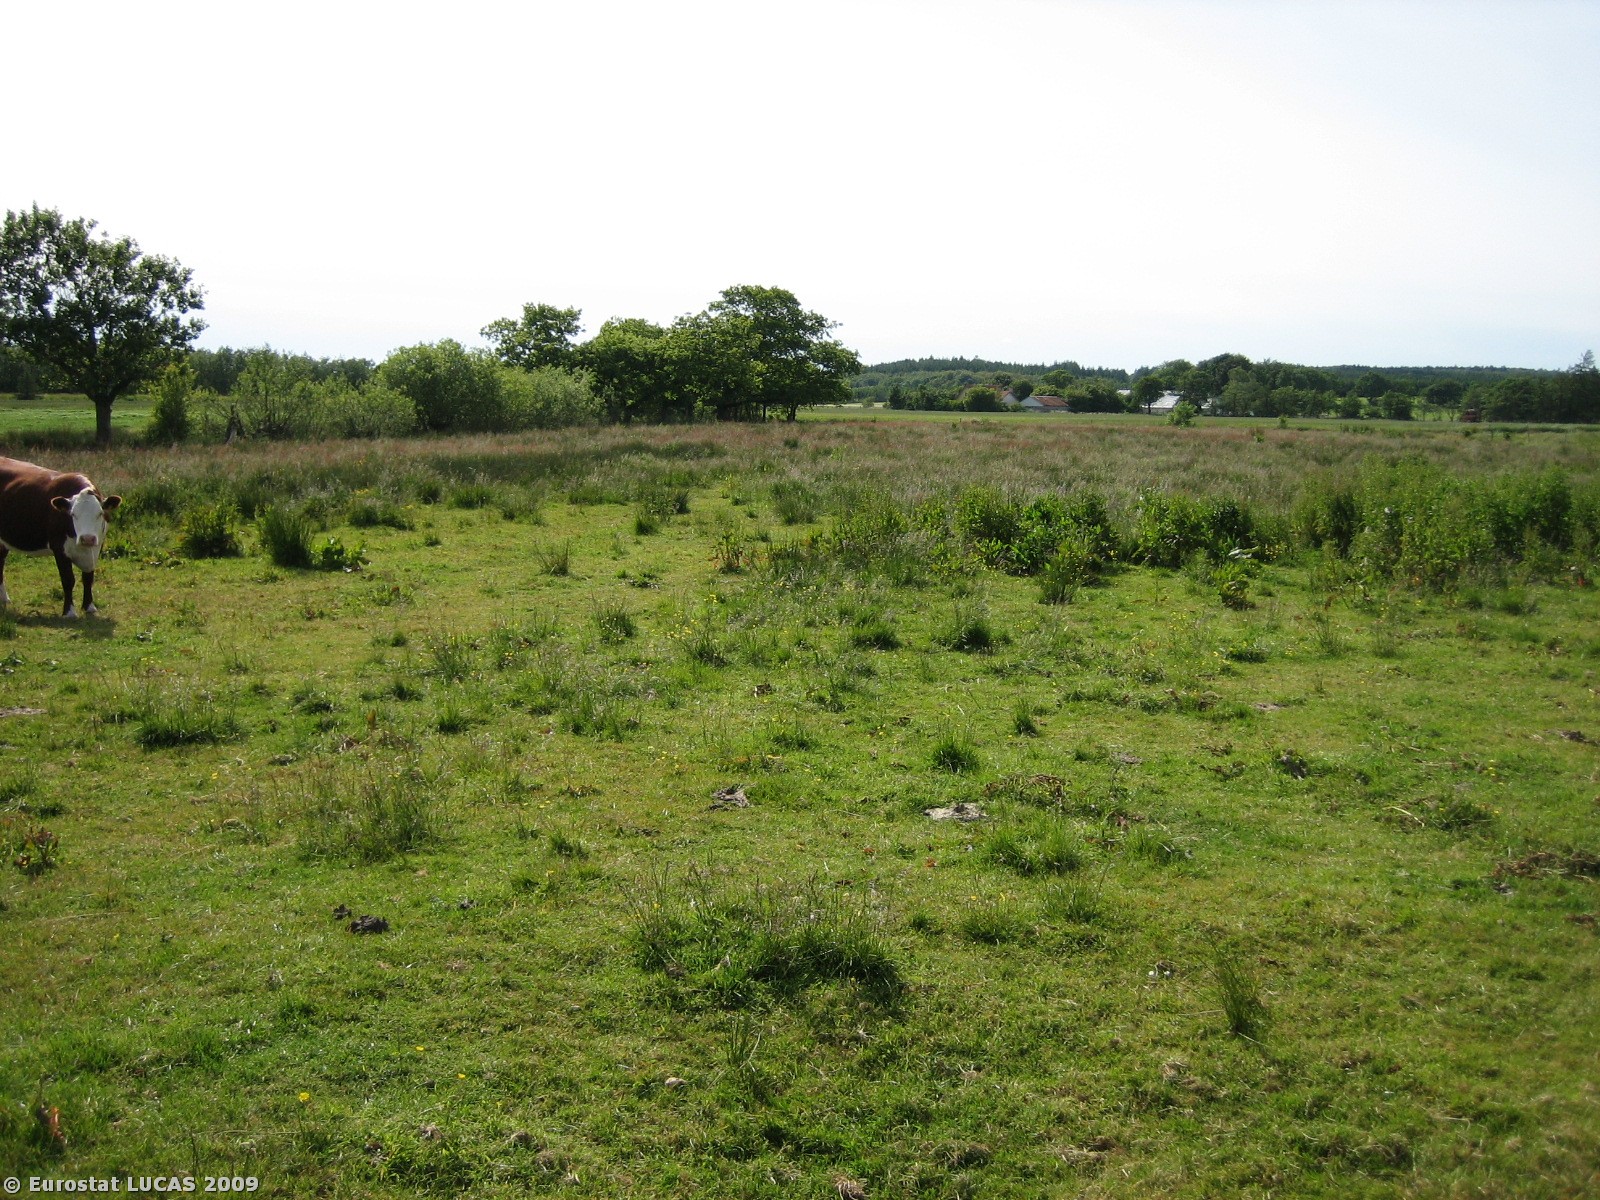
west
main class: Cropland
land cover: Common wheat
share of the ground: > 75 %
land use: Agriculture (excluding fallow land and kitchen gardens)
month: June
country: DK
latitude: 55.7545
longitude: 9.3156
